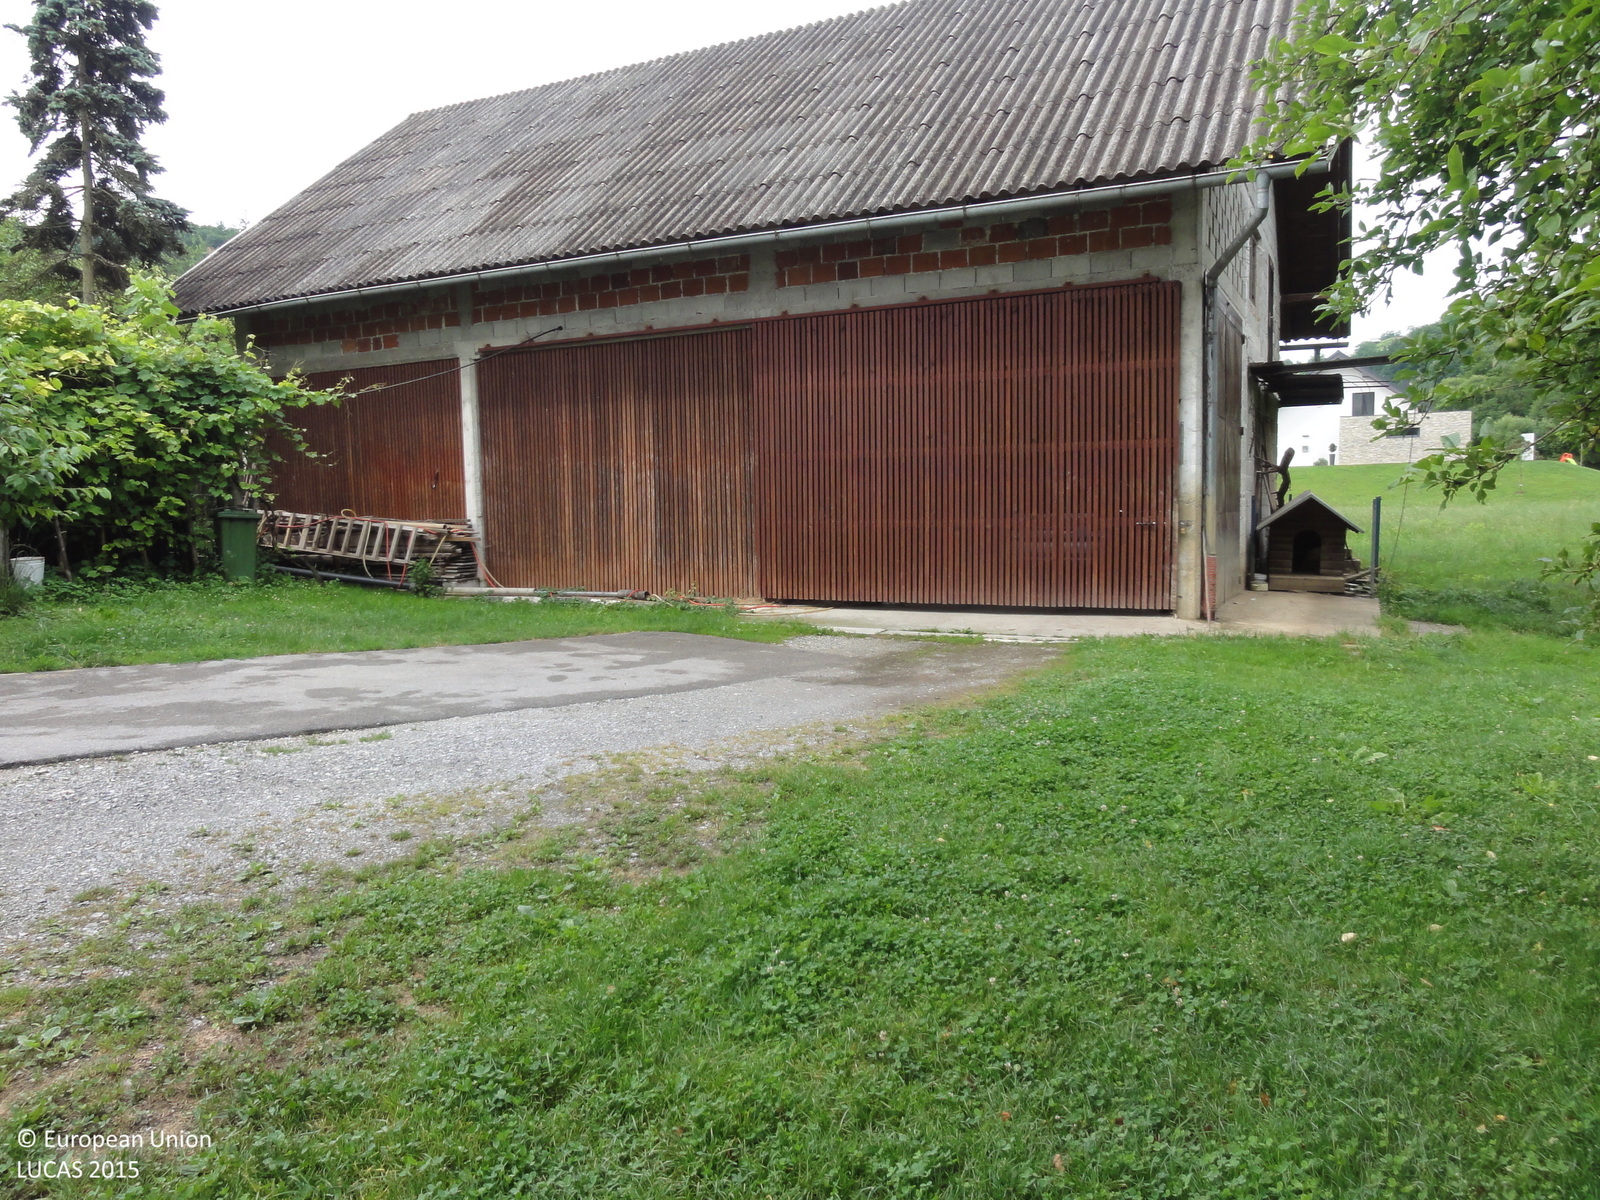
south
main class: Grassland
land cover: Grassland without tree/shrub cover
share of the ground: > 75 %
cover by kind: herbaceous plants 100 %
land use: Residential
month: June
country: SI
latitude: 46.2273
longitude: 15.5084
